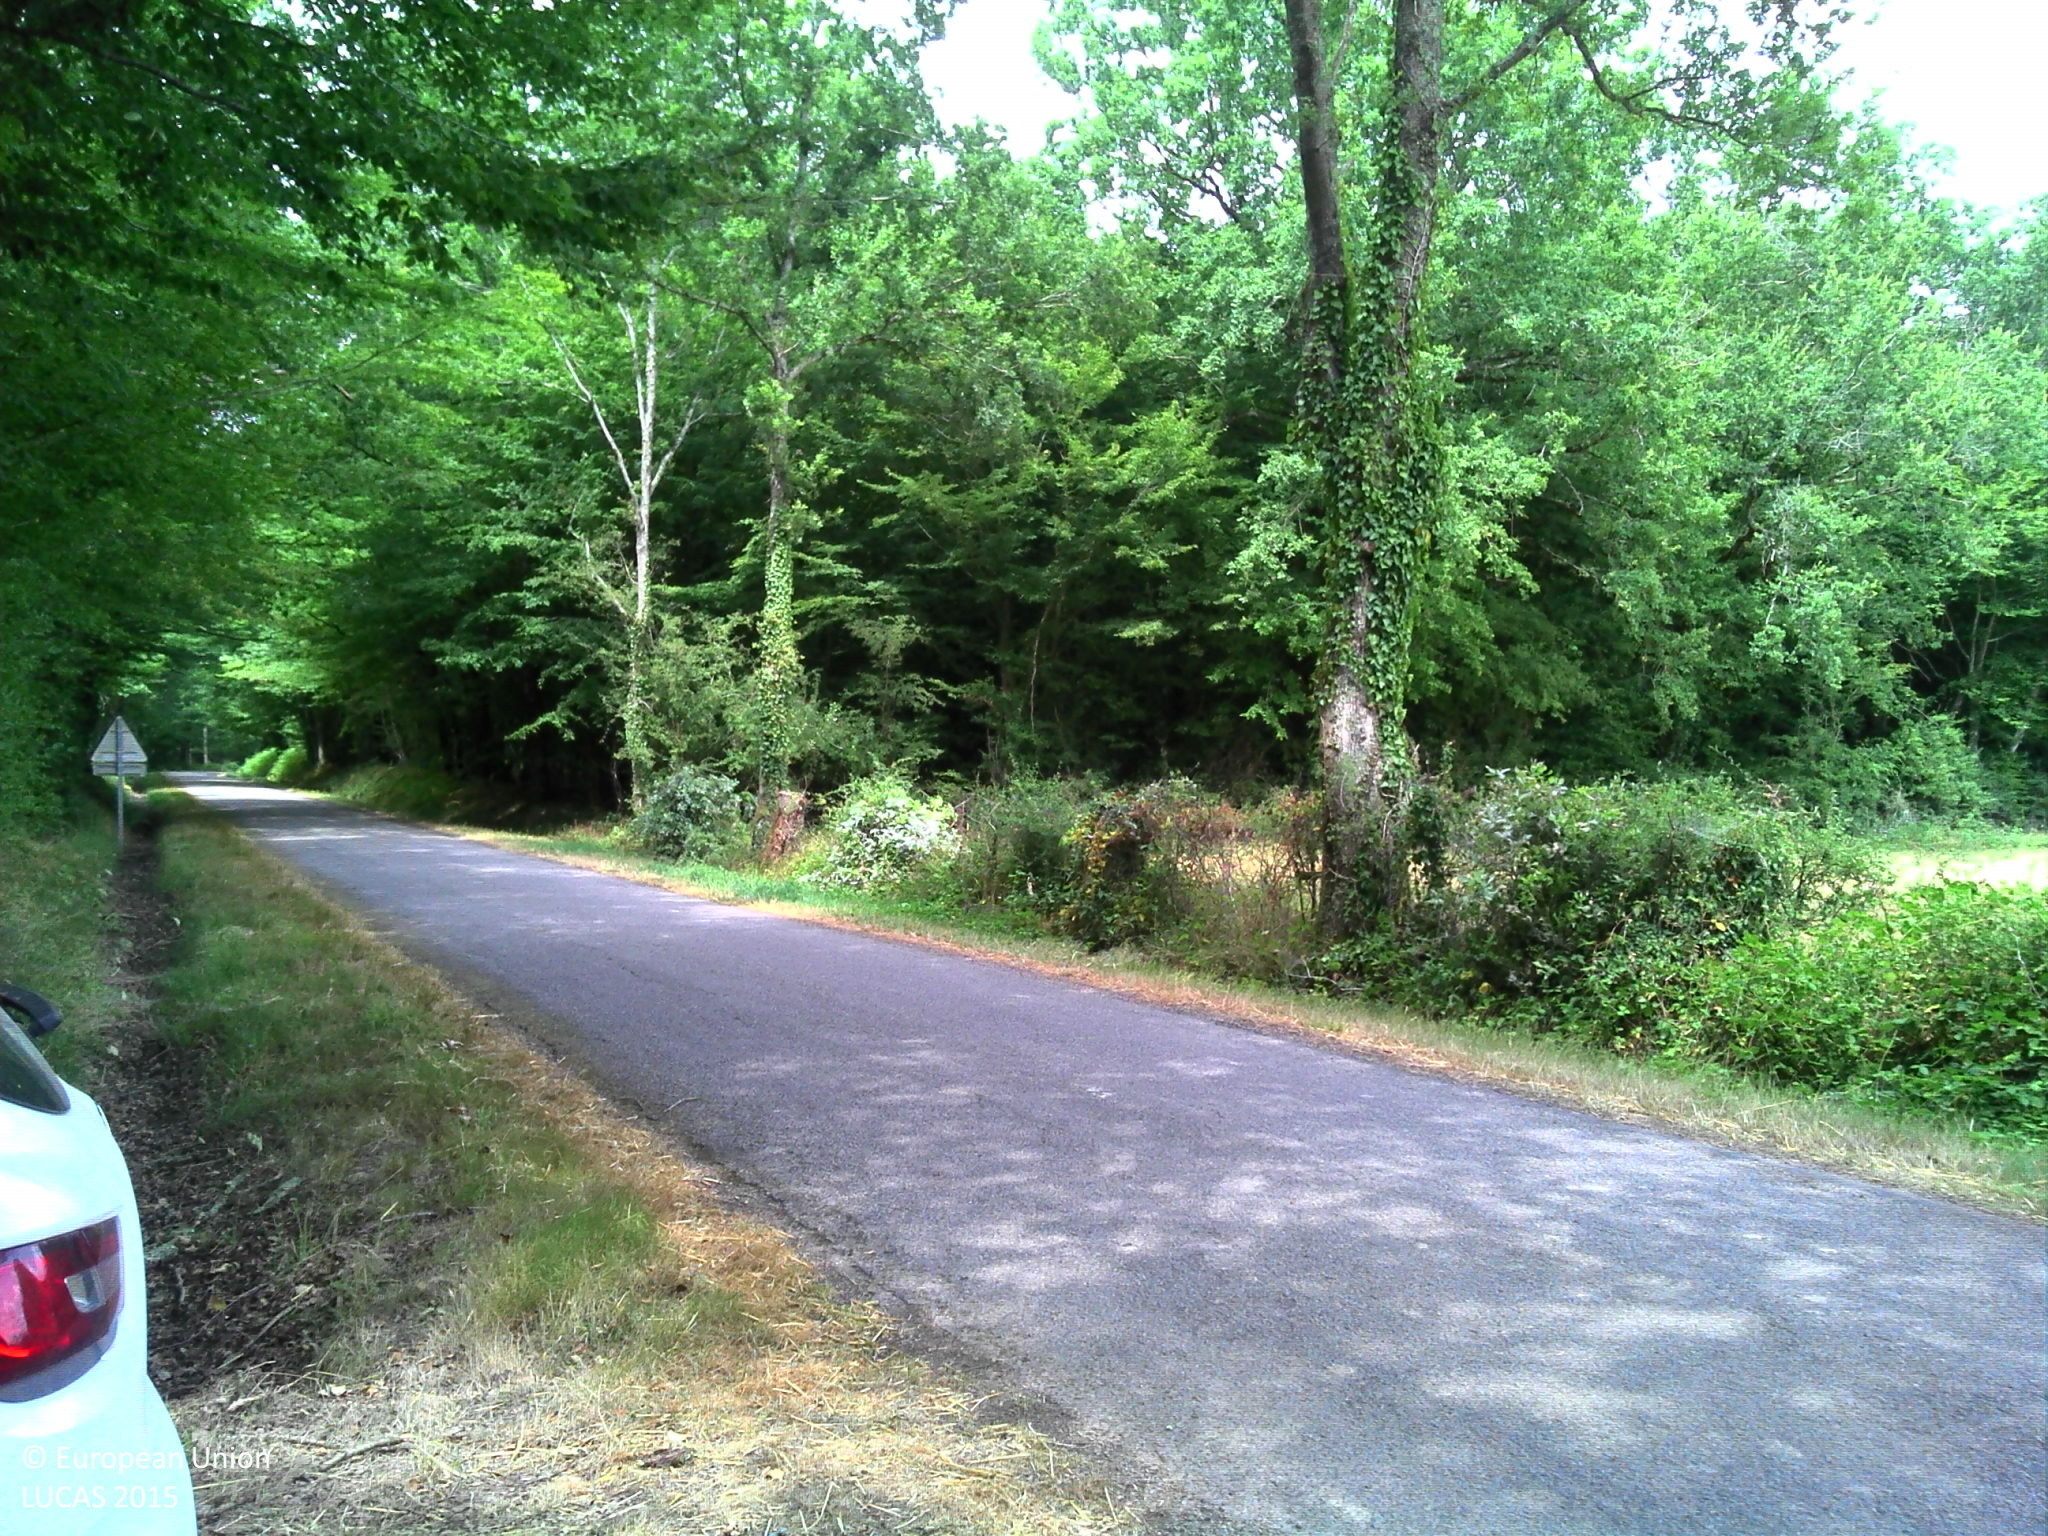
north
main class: Woodland
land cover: Broadleaved woodland
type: mesophytic deciduous forest
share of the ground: > 75 %
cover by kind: broadleaved forest trees 90 %, shrubs 5 %, herbaceous plants 5 %
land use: Forestry
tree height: > 5 m
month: July
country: FR
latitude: 46.6430
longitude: 2.9548
